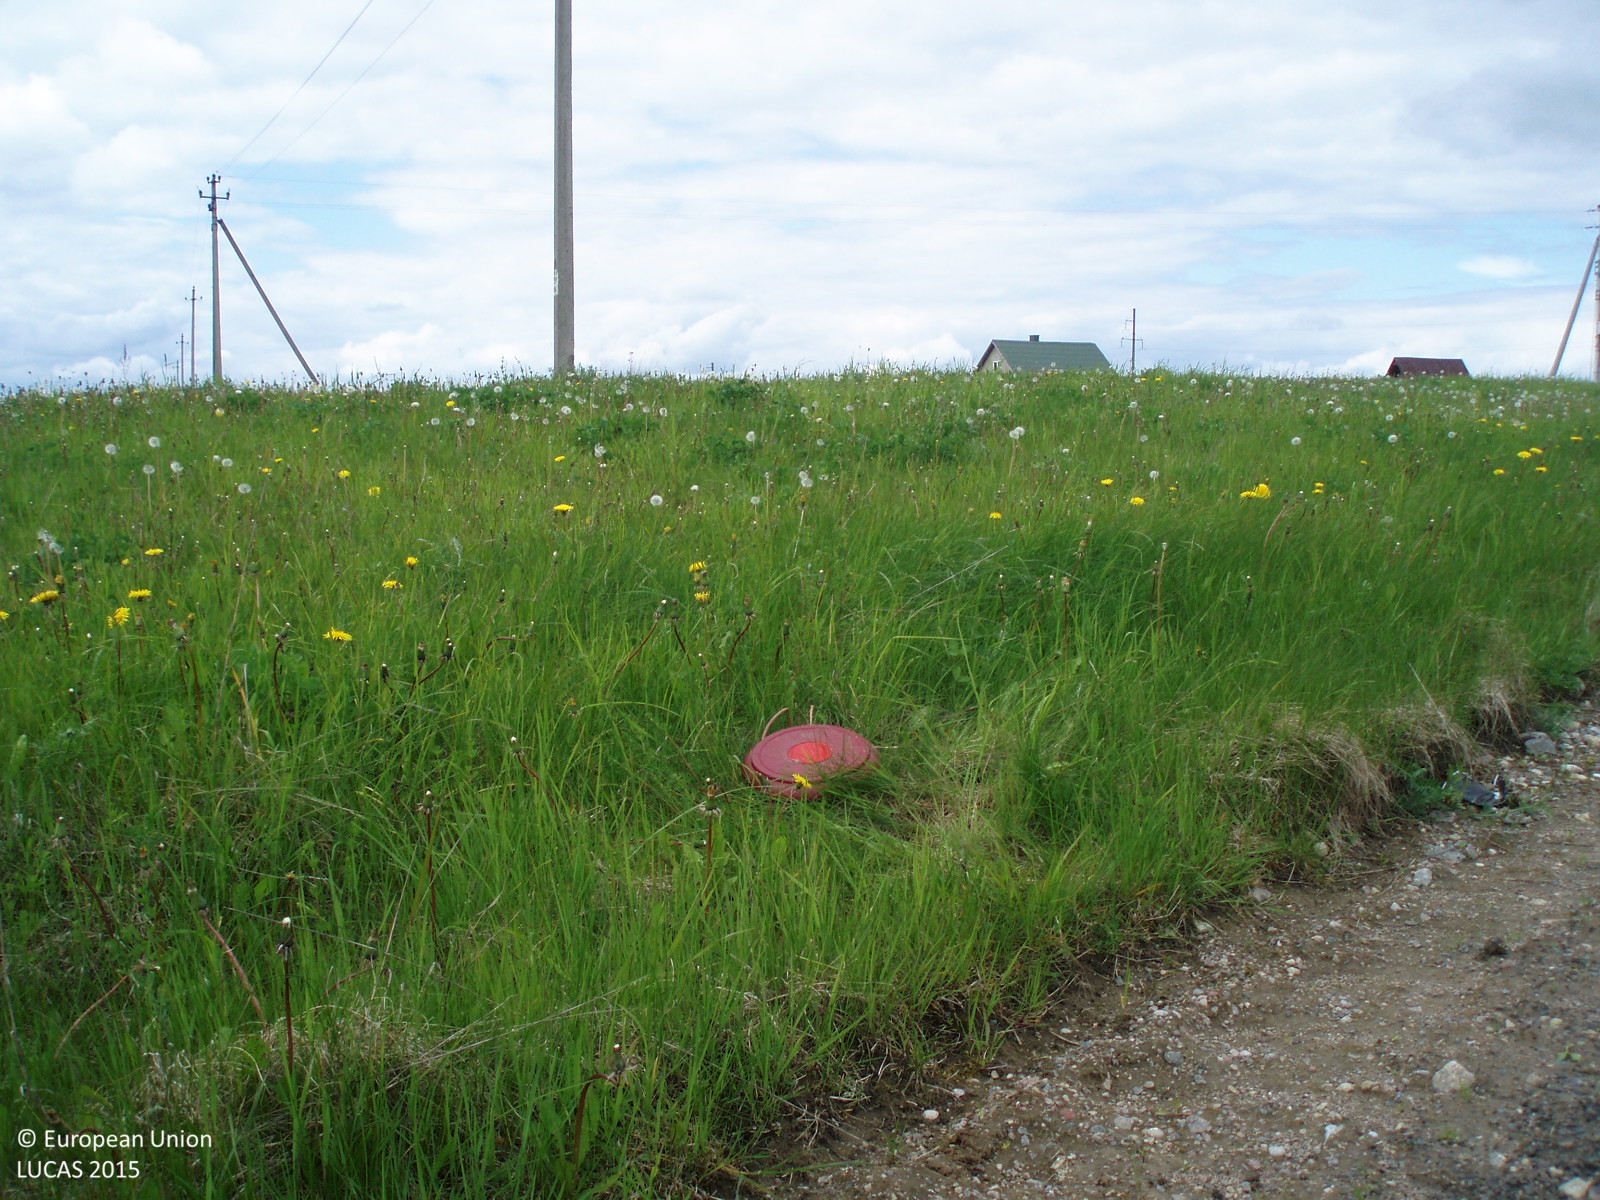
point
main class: Grassland
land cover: Grassland without tree/shrub cover
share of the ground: > 75 %
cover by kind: herbaceous plants 100 %
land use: Agriculture (excluding fallow land and kitchen gardens)
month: May
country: LT
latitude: 56.2746
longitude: 22.4111
